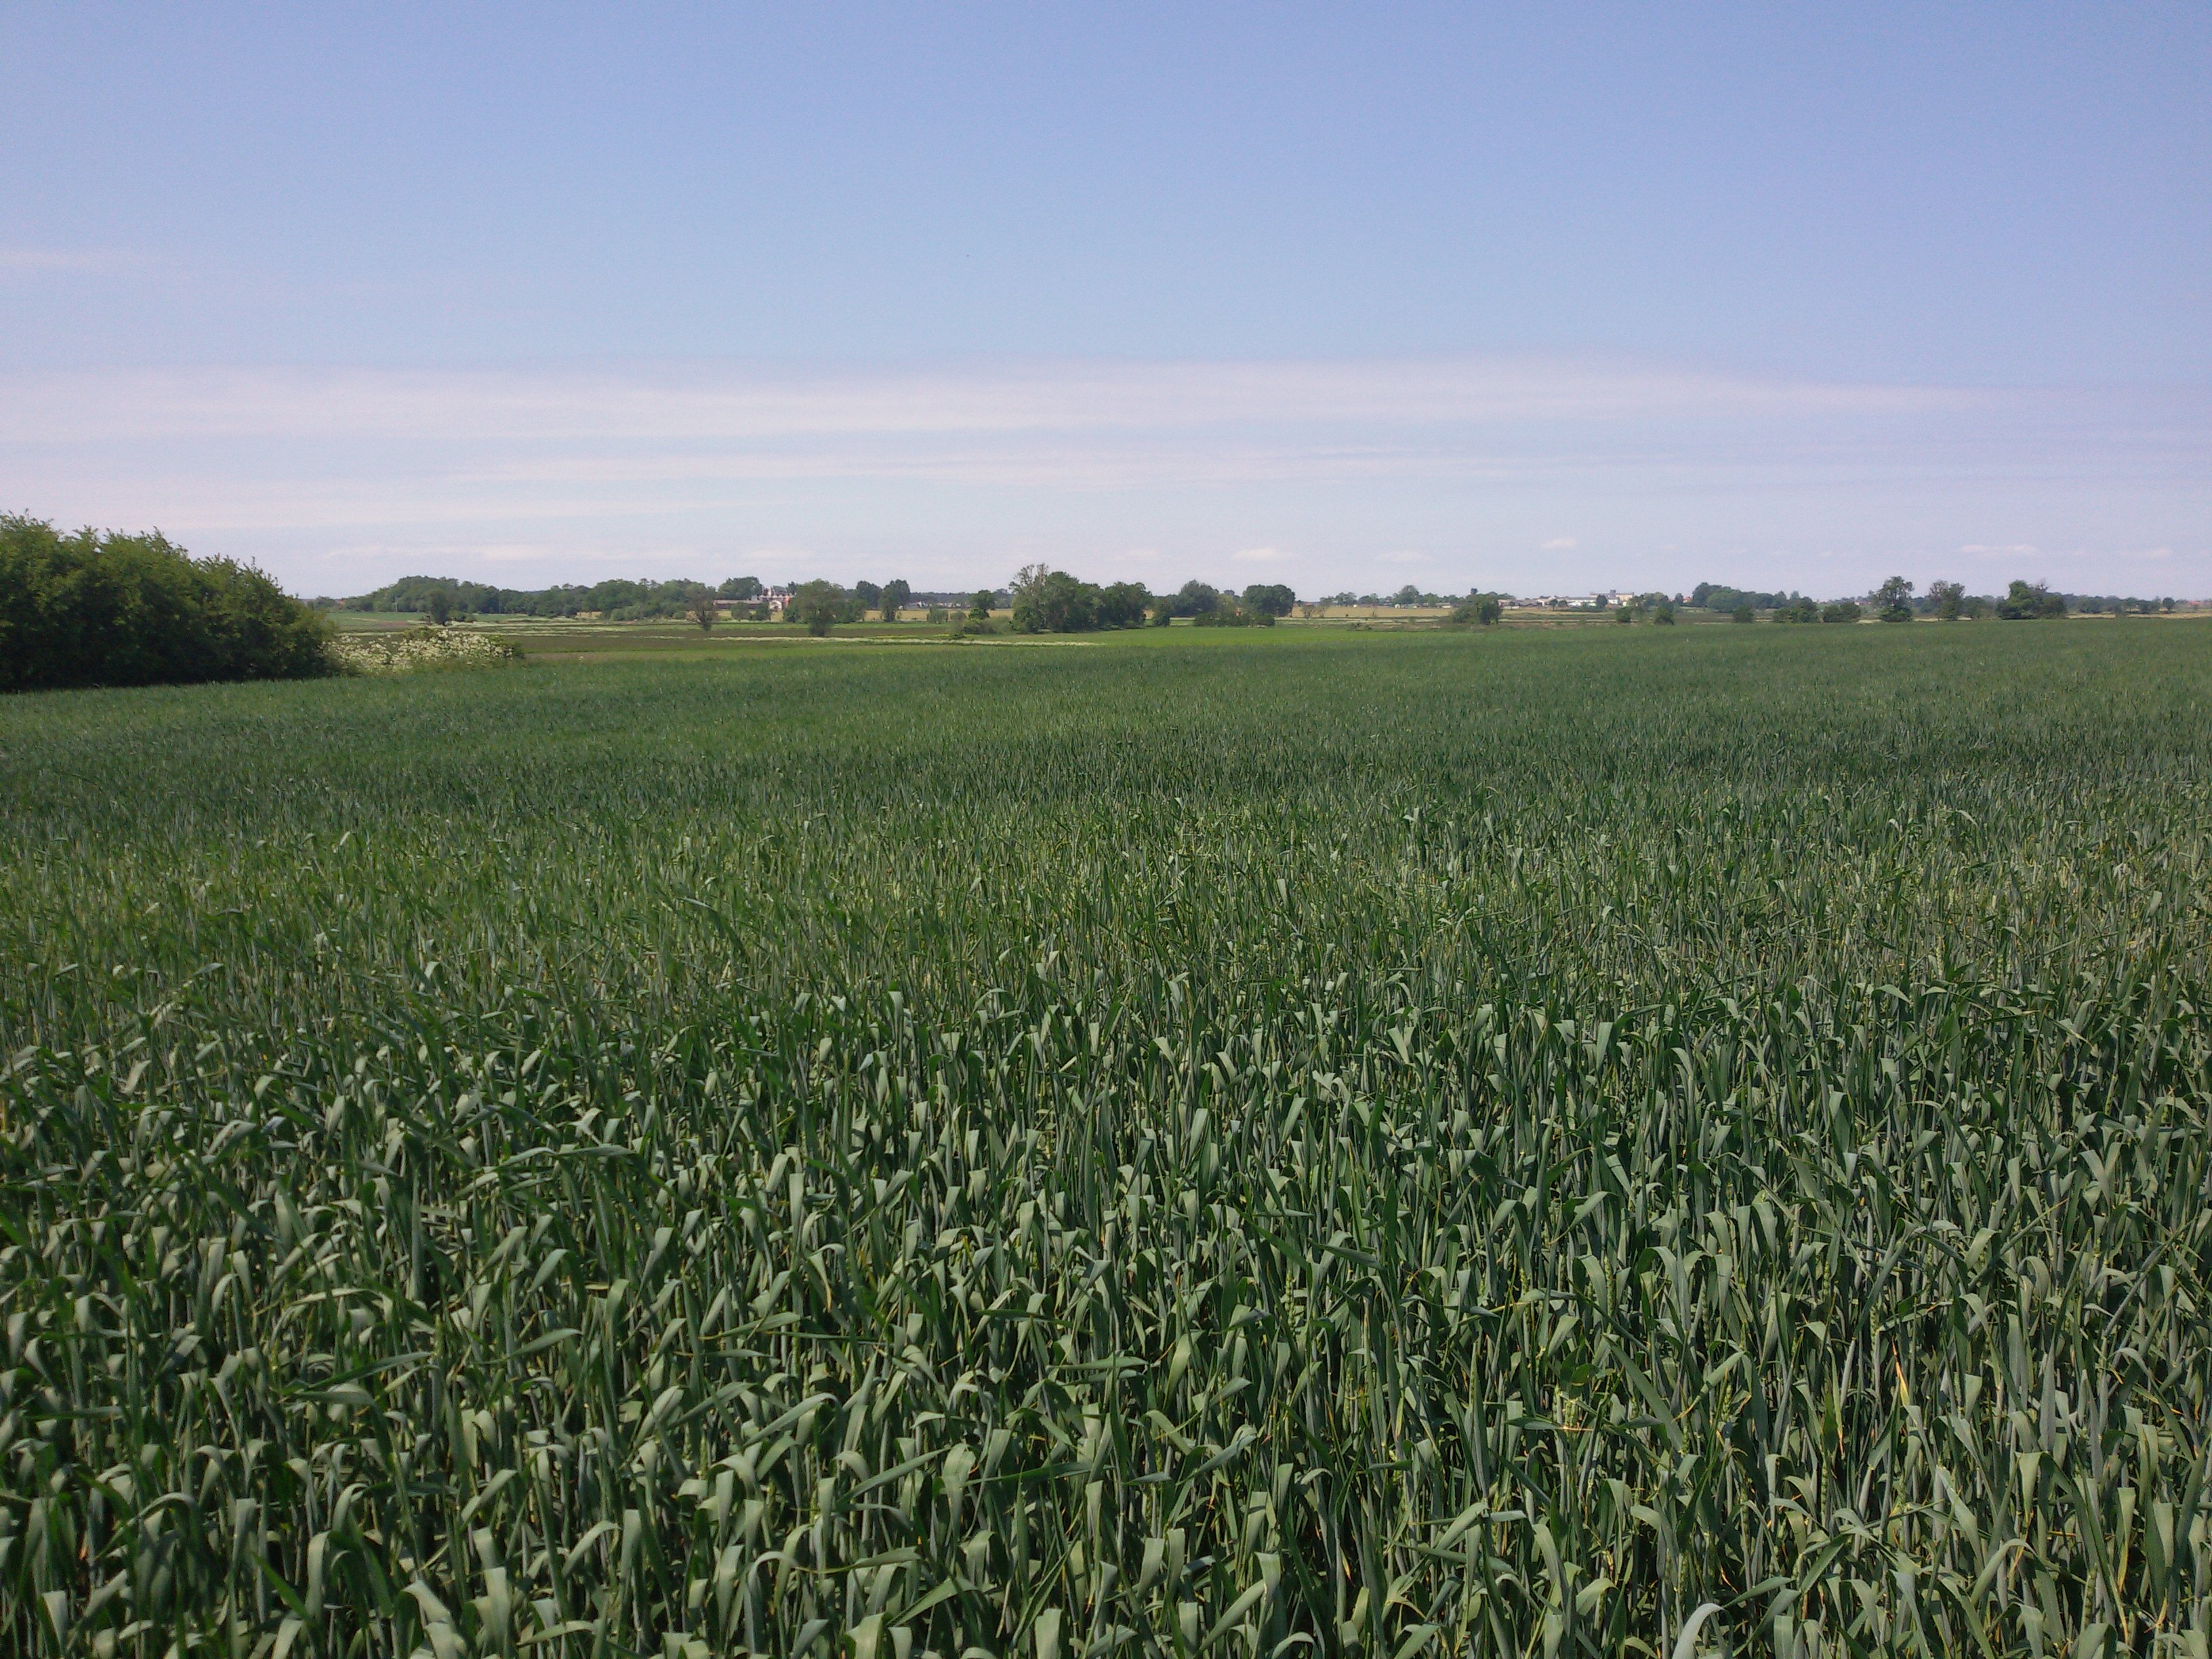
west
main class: Cropland
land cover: Rape and turnip rape
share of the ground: > 75 %
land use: Agriculture (excluding fallow land and kitchen gardens)
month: May
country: PL
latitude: 52.2881
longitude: 17.1502
